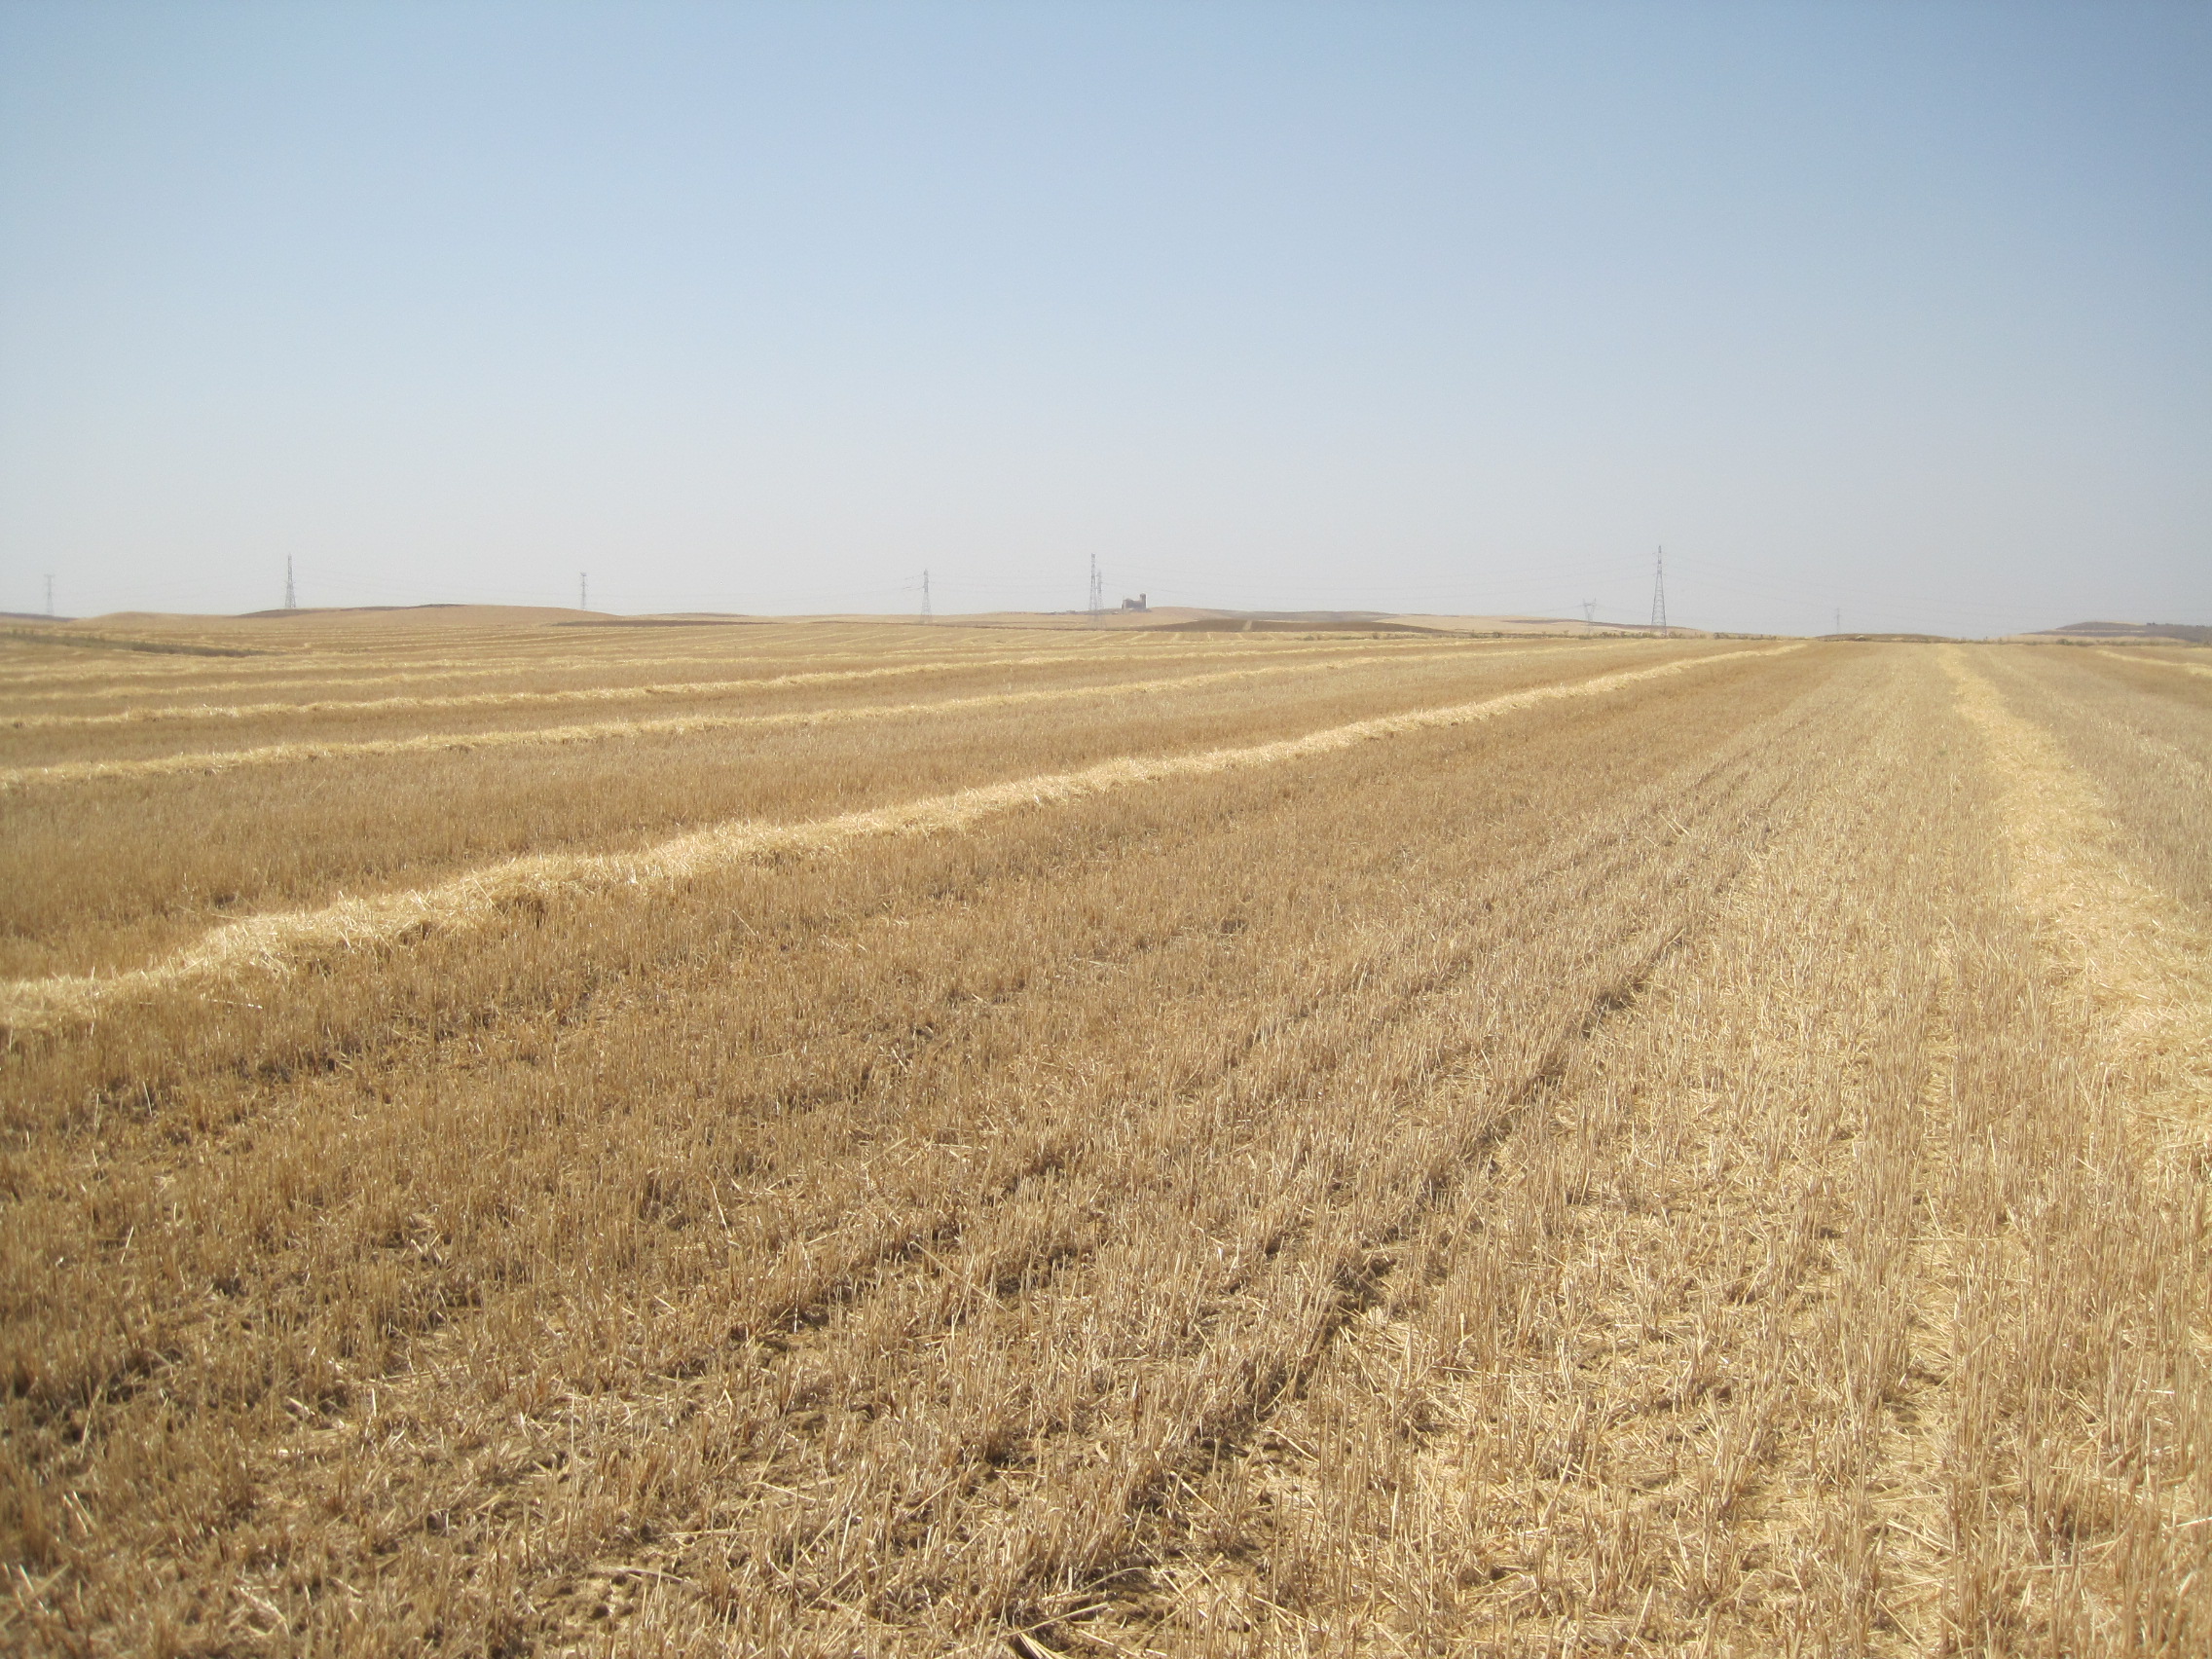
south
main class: Cropland
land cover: Barley
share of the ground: < 10 %
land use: Agriculture (excluding fallow land and kitchen gardens)
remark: Harvested field
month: July
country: ES
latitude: 41.6596
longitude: -5.4665
